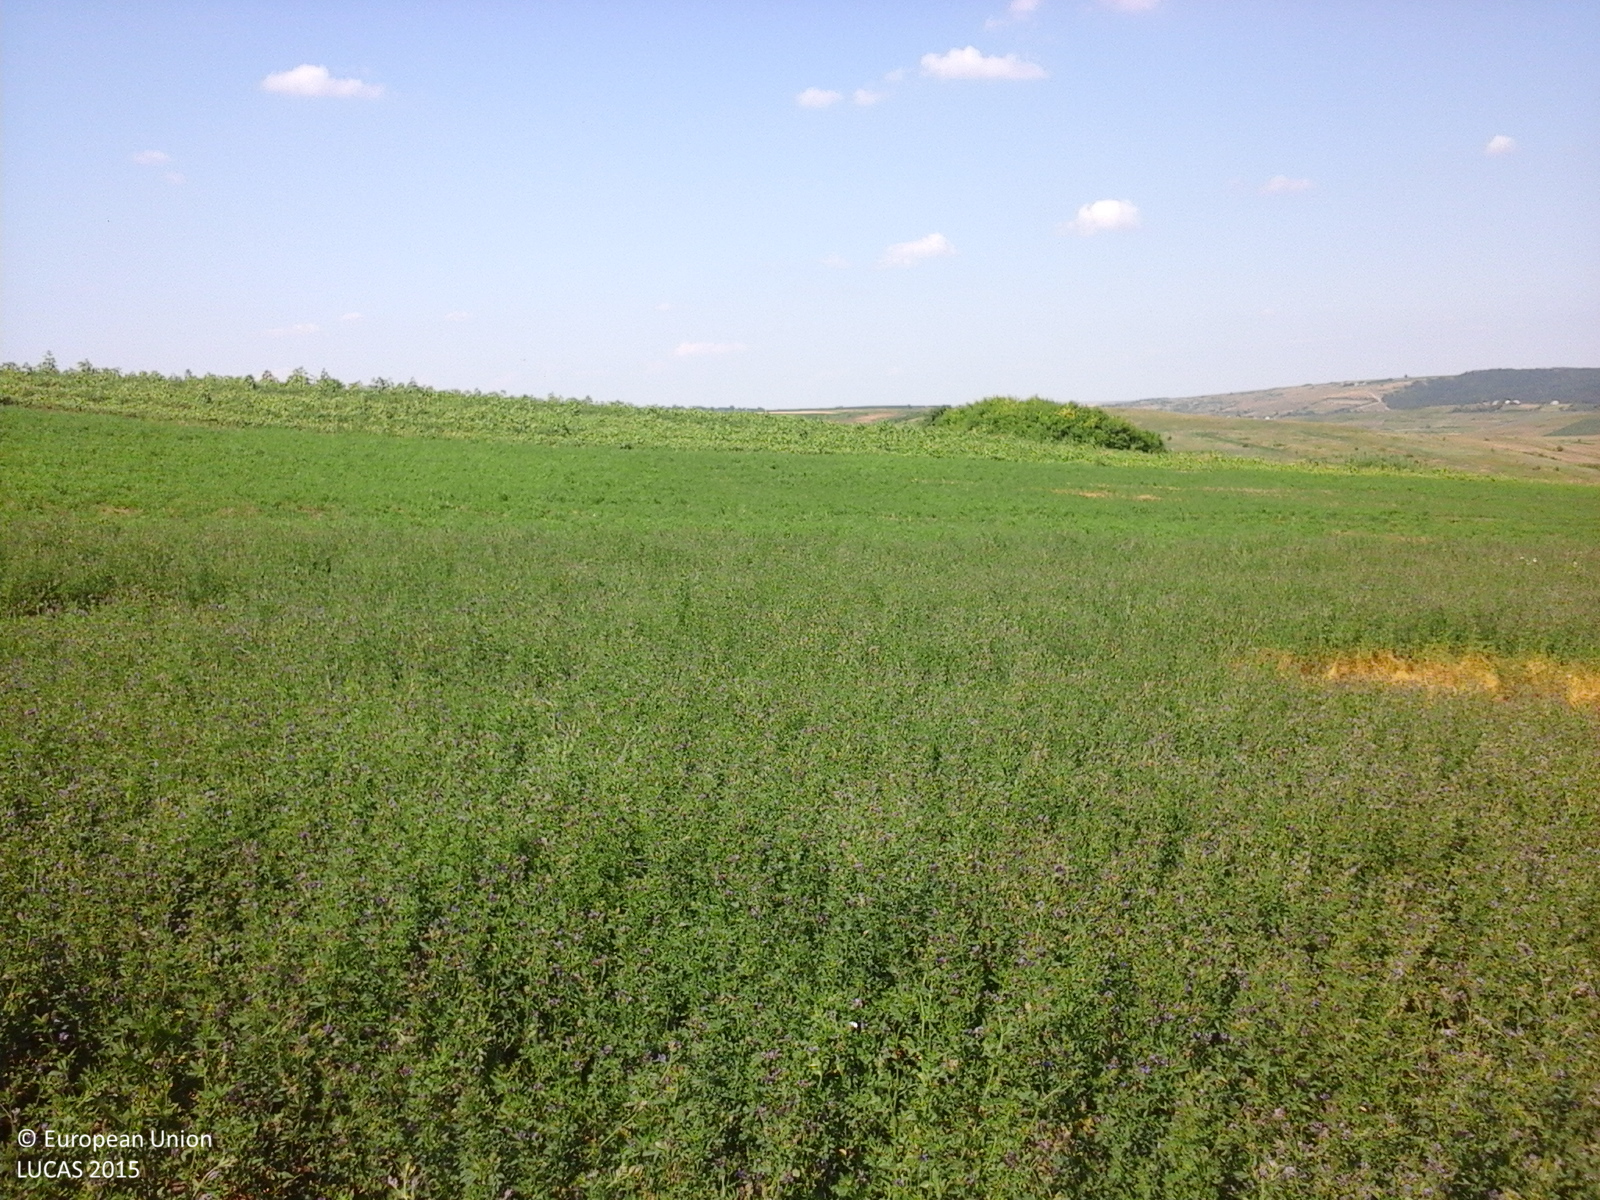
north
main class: Cropland
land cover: Lucerne
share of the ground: > 75 %
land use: Agriculture (excluding fallow land and kitchen gardens)
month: June
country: RO
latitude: 47.1246
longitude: 27.2576
